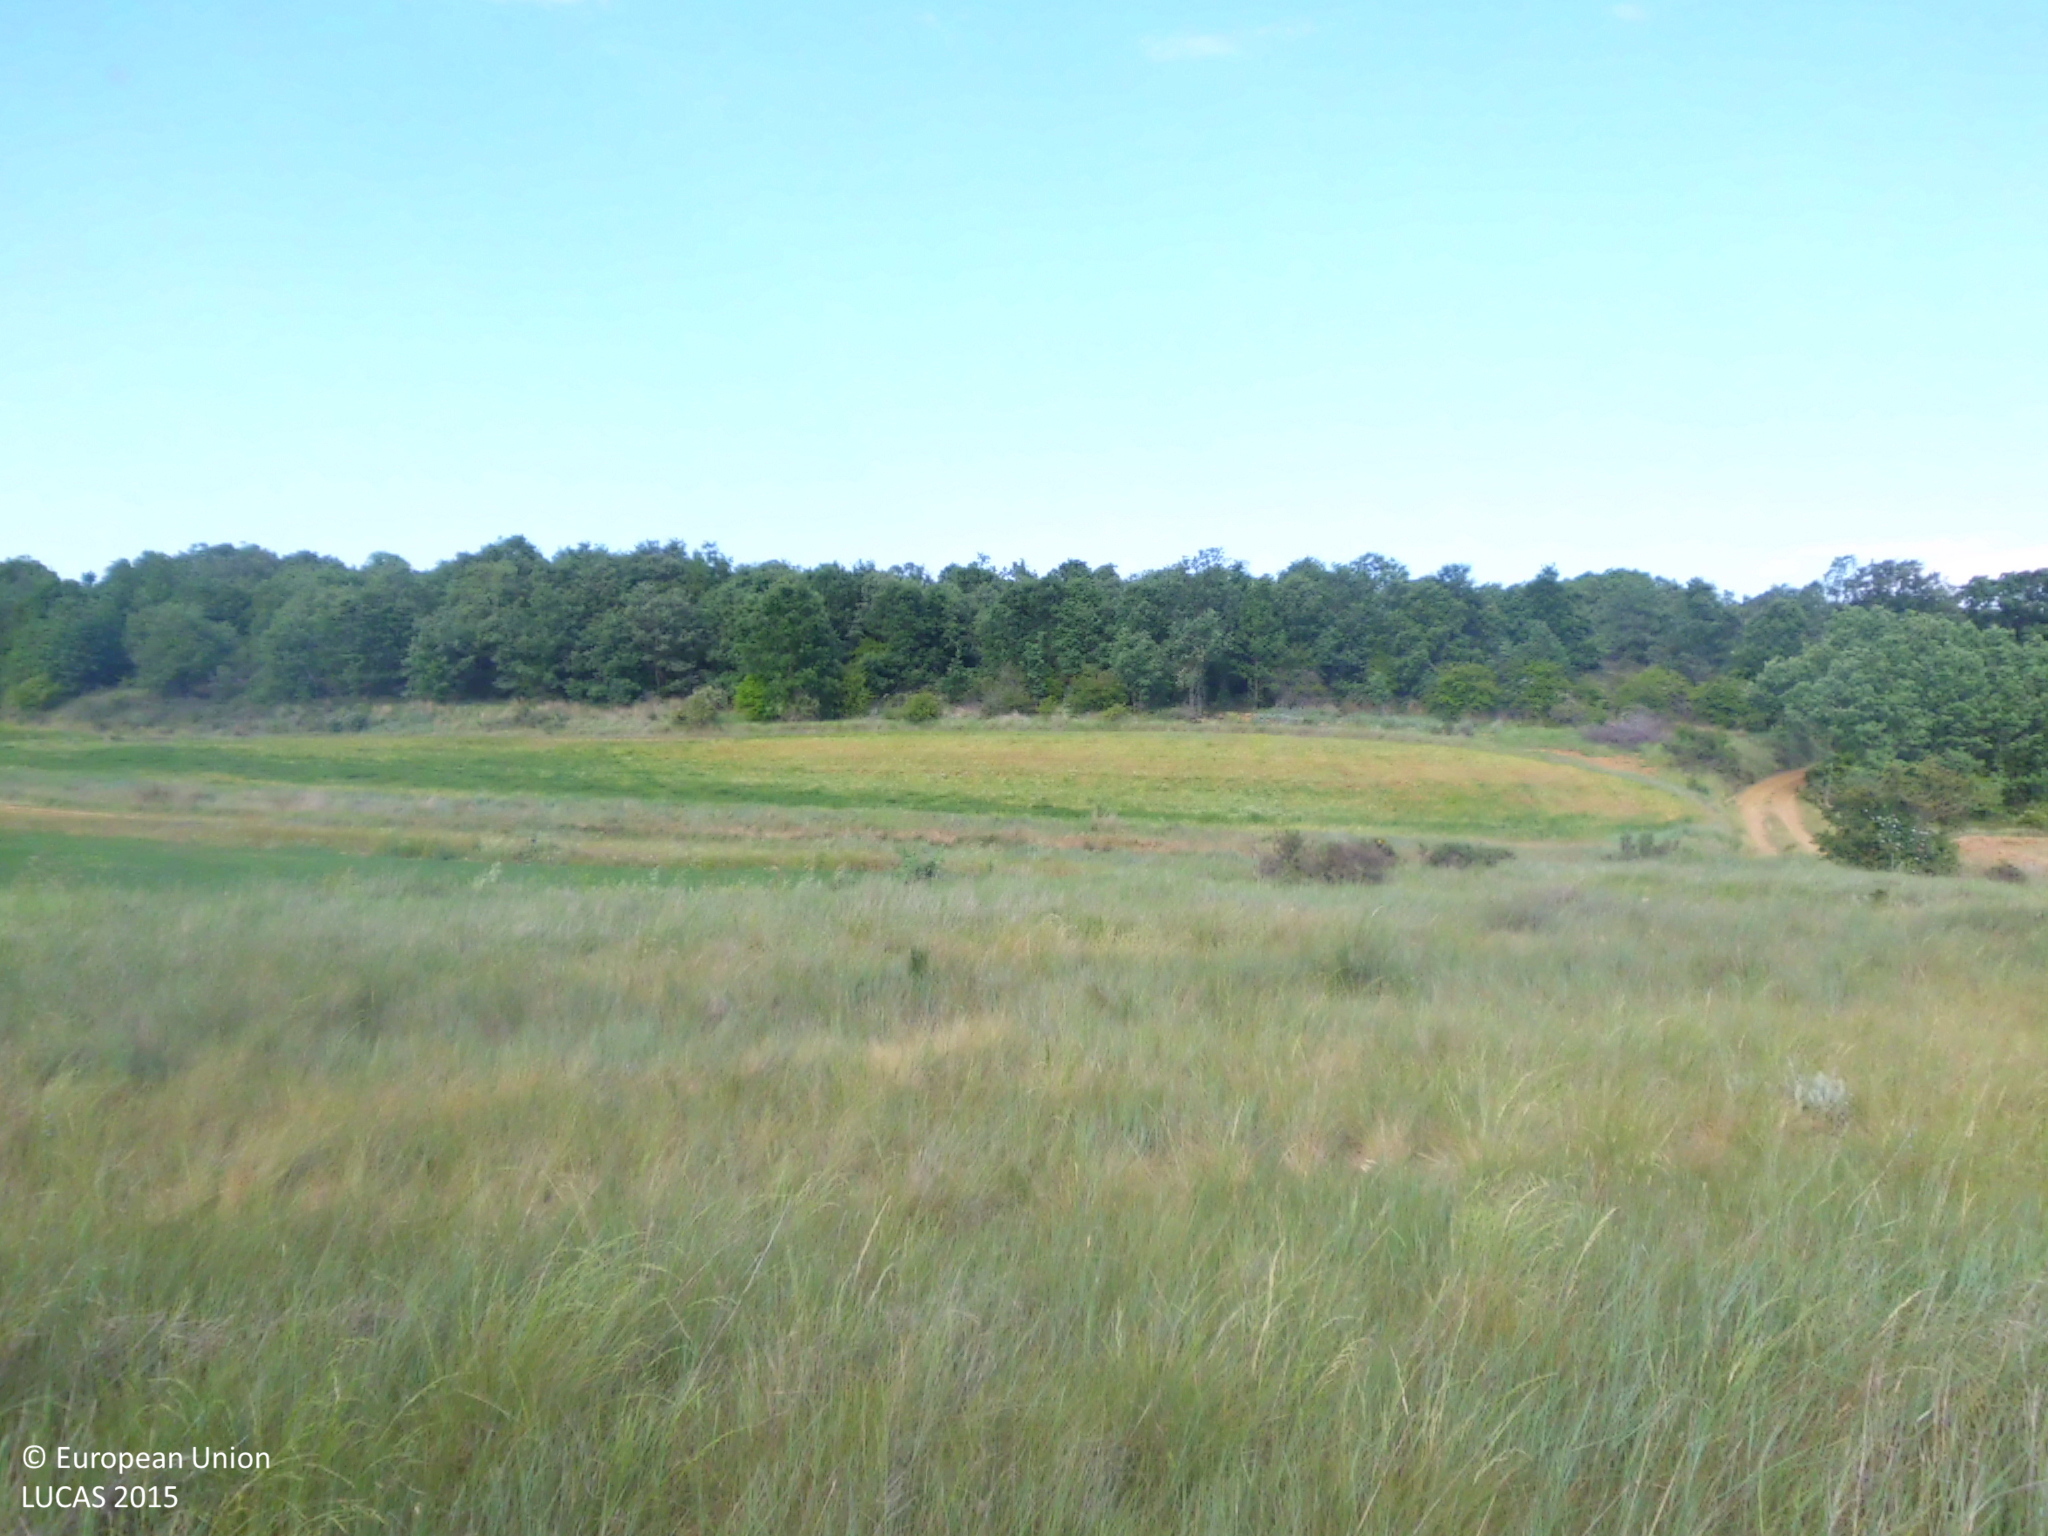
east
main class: Grassland
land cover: Grassland without tree/shrub cover
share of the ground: > 75 %
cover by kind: herbaceous plants 100 %
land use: Agriculture (excluding fallow land and kitchen gardens)
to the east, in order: Grassland without tree/shrub cover; Spontaneously vegetated surfaces; Tracks; Spontaneously vegetated surfaces; Broadleaved woodland; Ditches and canals; Broadleaved woodland; Tracks; Oats
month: June
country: ES
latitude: 42.4952
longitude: -4.4195
